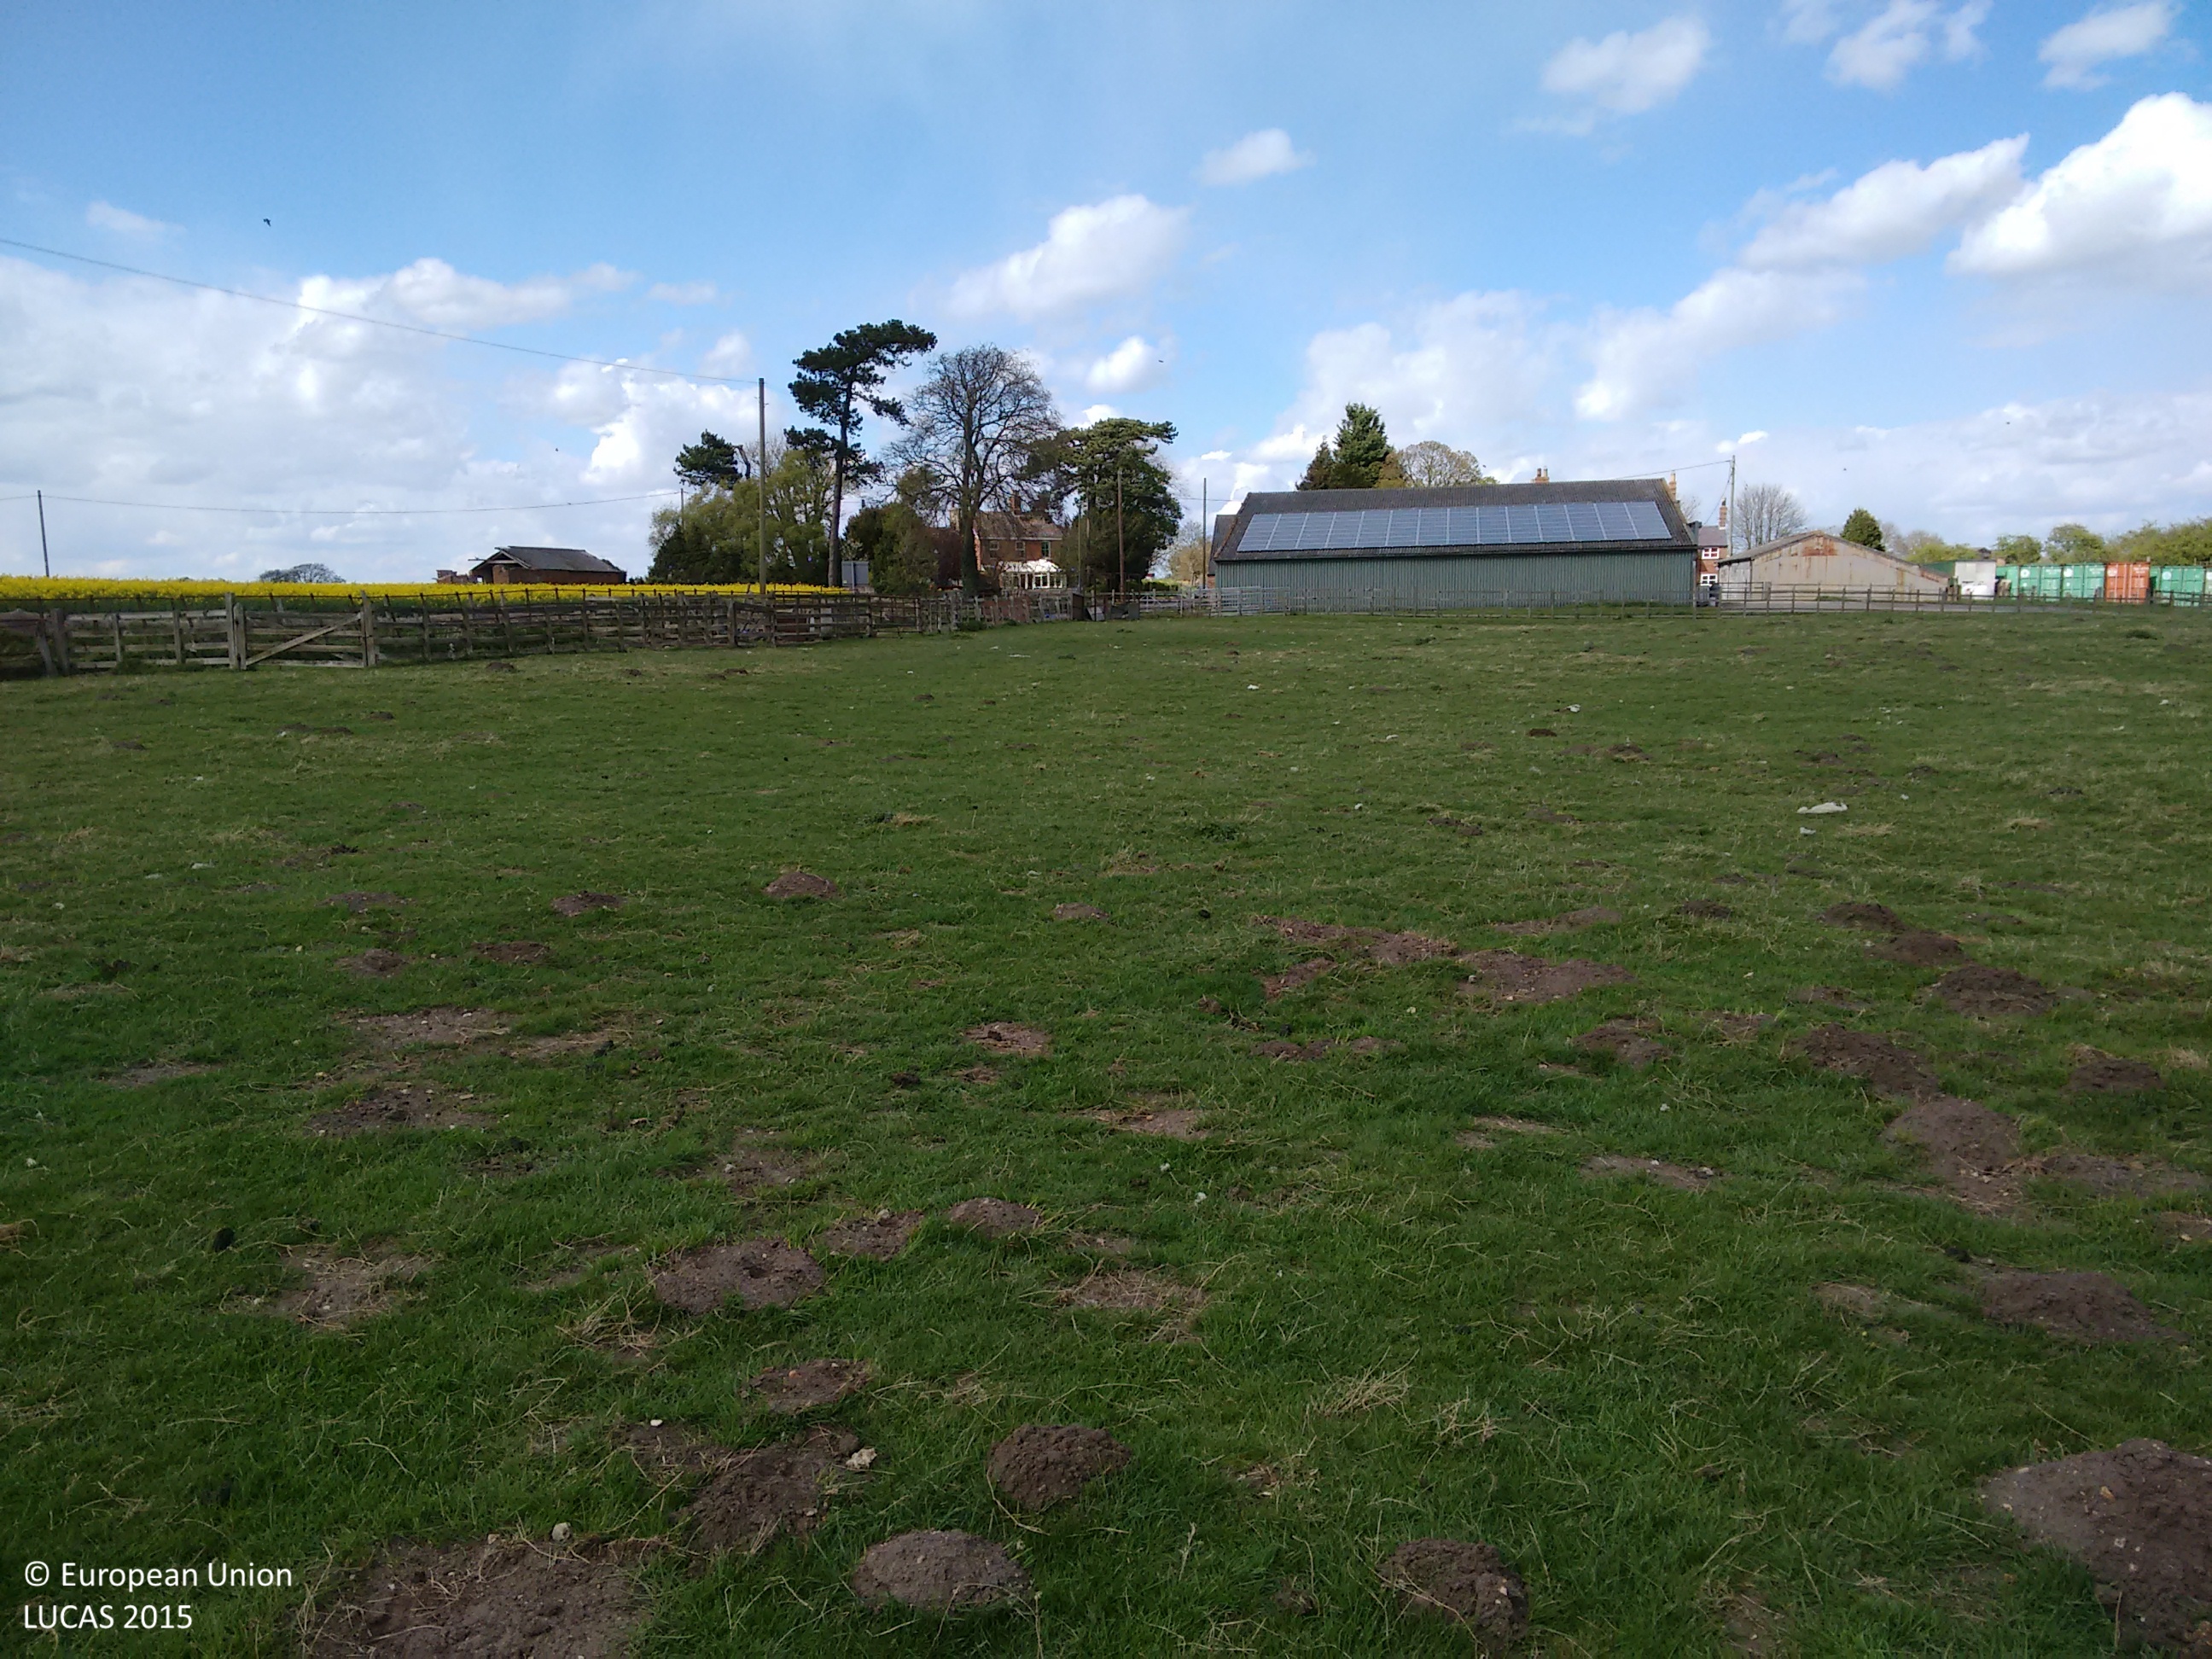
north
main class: Grassland
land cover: Grassland without tree/shrub cover
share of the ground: > 75 %
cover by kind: herbaceous plants 100 %
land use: Agriculture (excluding fallow land and kitchen gardens)
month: April
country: GB
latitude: 53.1930
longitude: -0.1365
